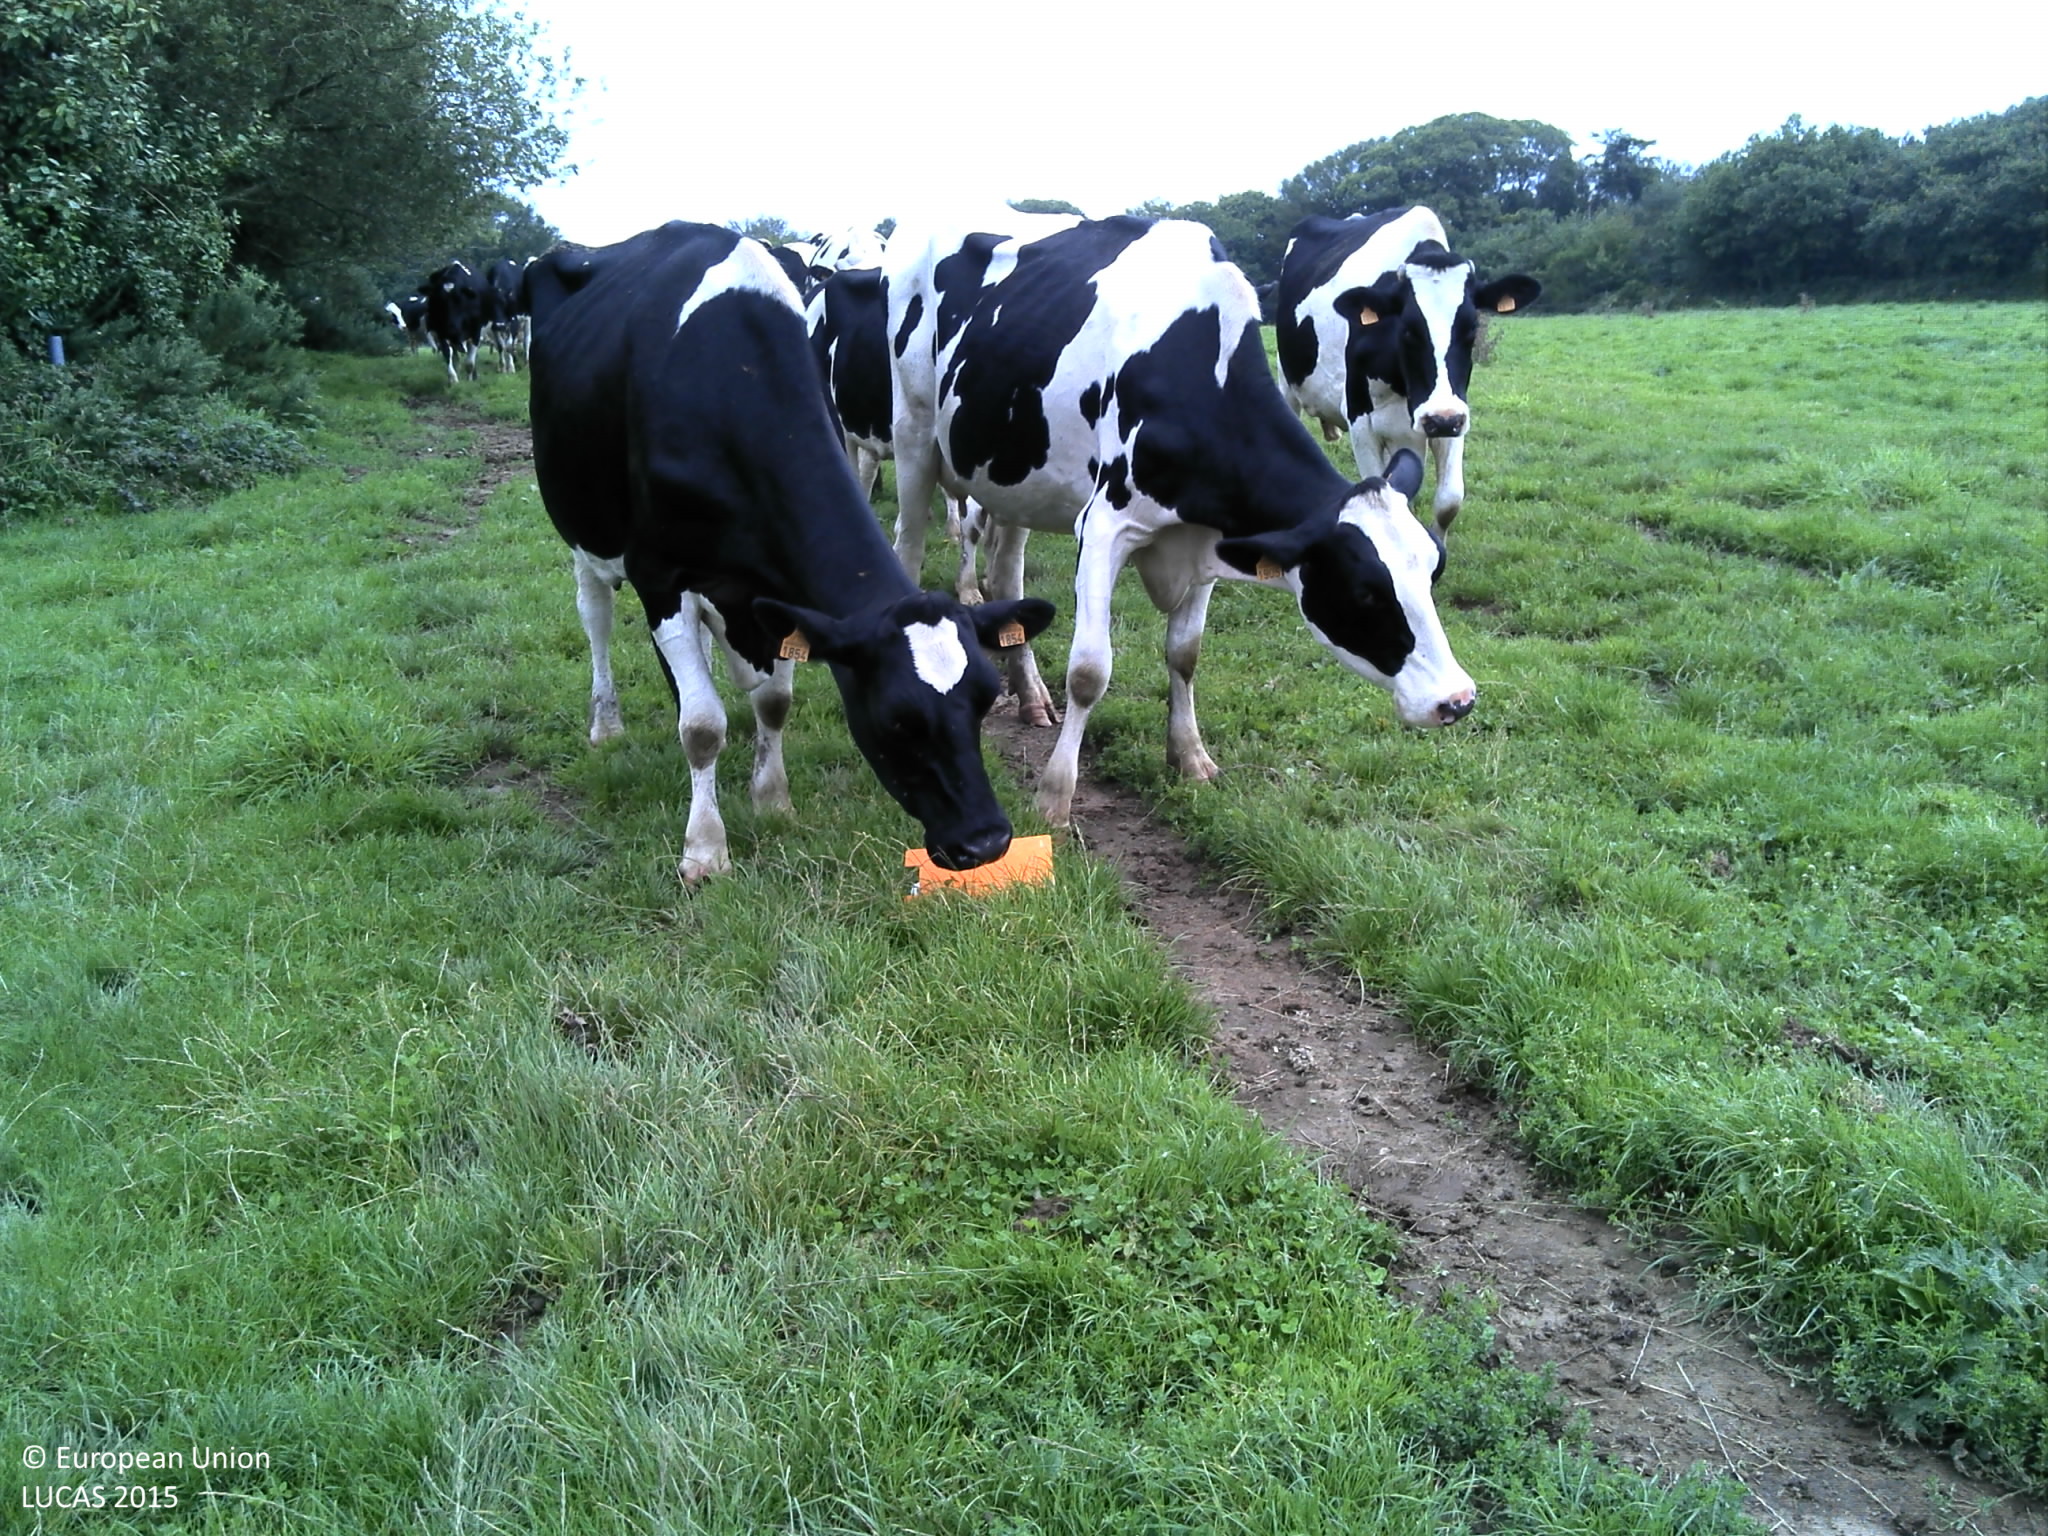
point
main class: Grassland
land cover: Grassland without tree/shrub cover
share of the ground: > 75 %
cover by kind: herbaceous plants 100 %
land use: Agriculture (excluding fallow land and kitchen gardens)
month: August
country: FR
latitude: 48.5488
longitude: -4.2780
